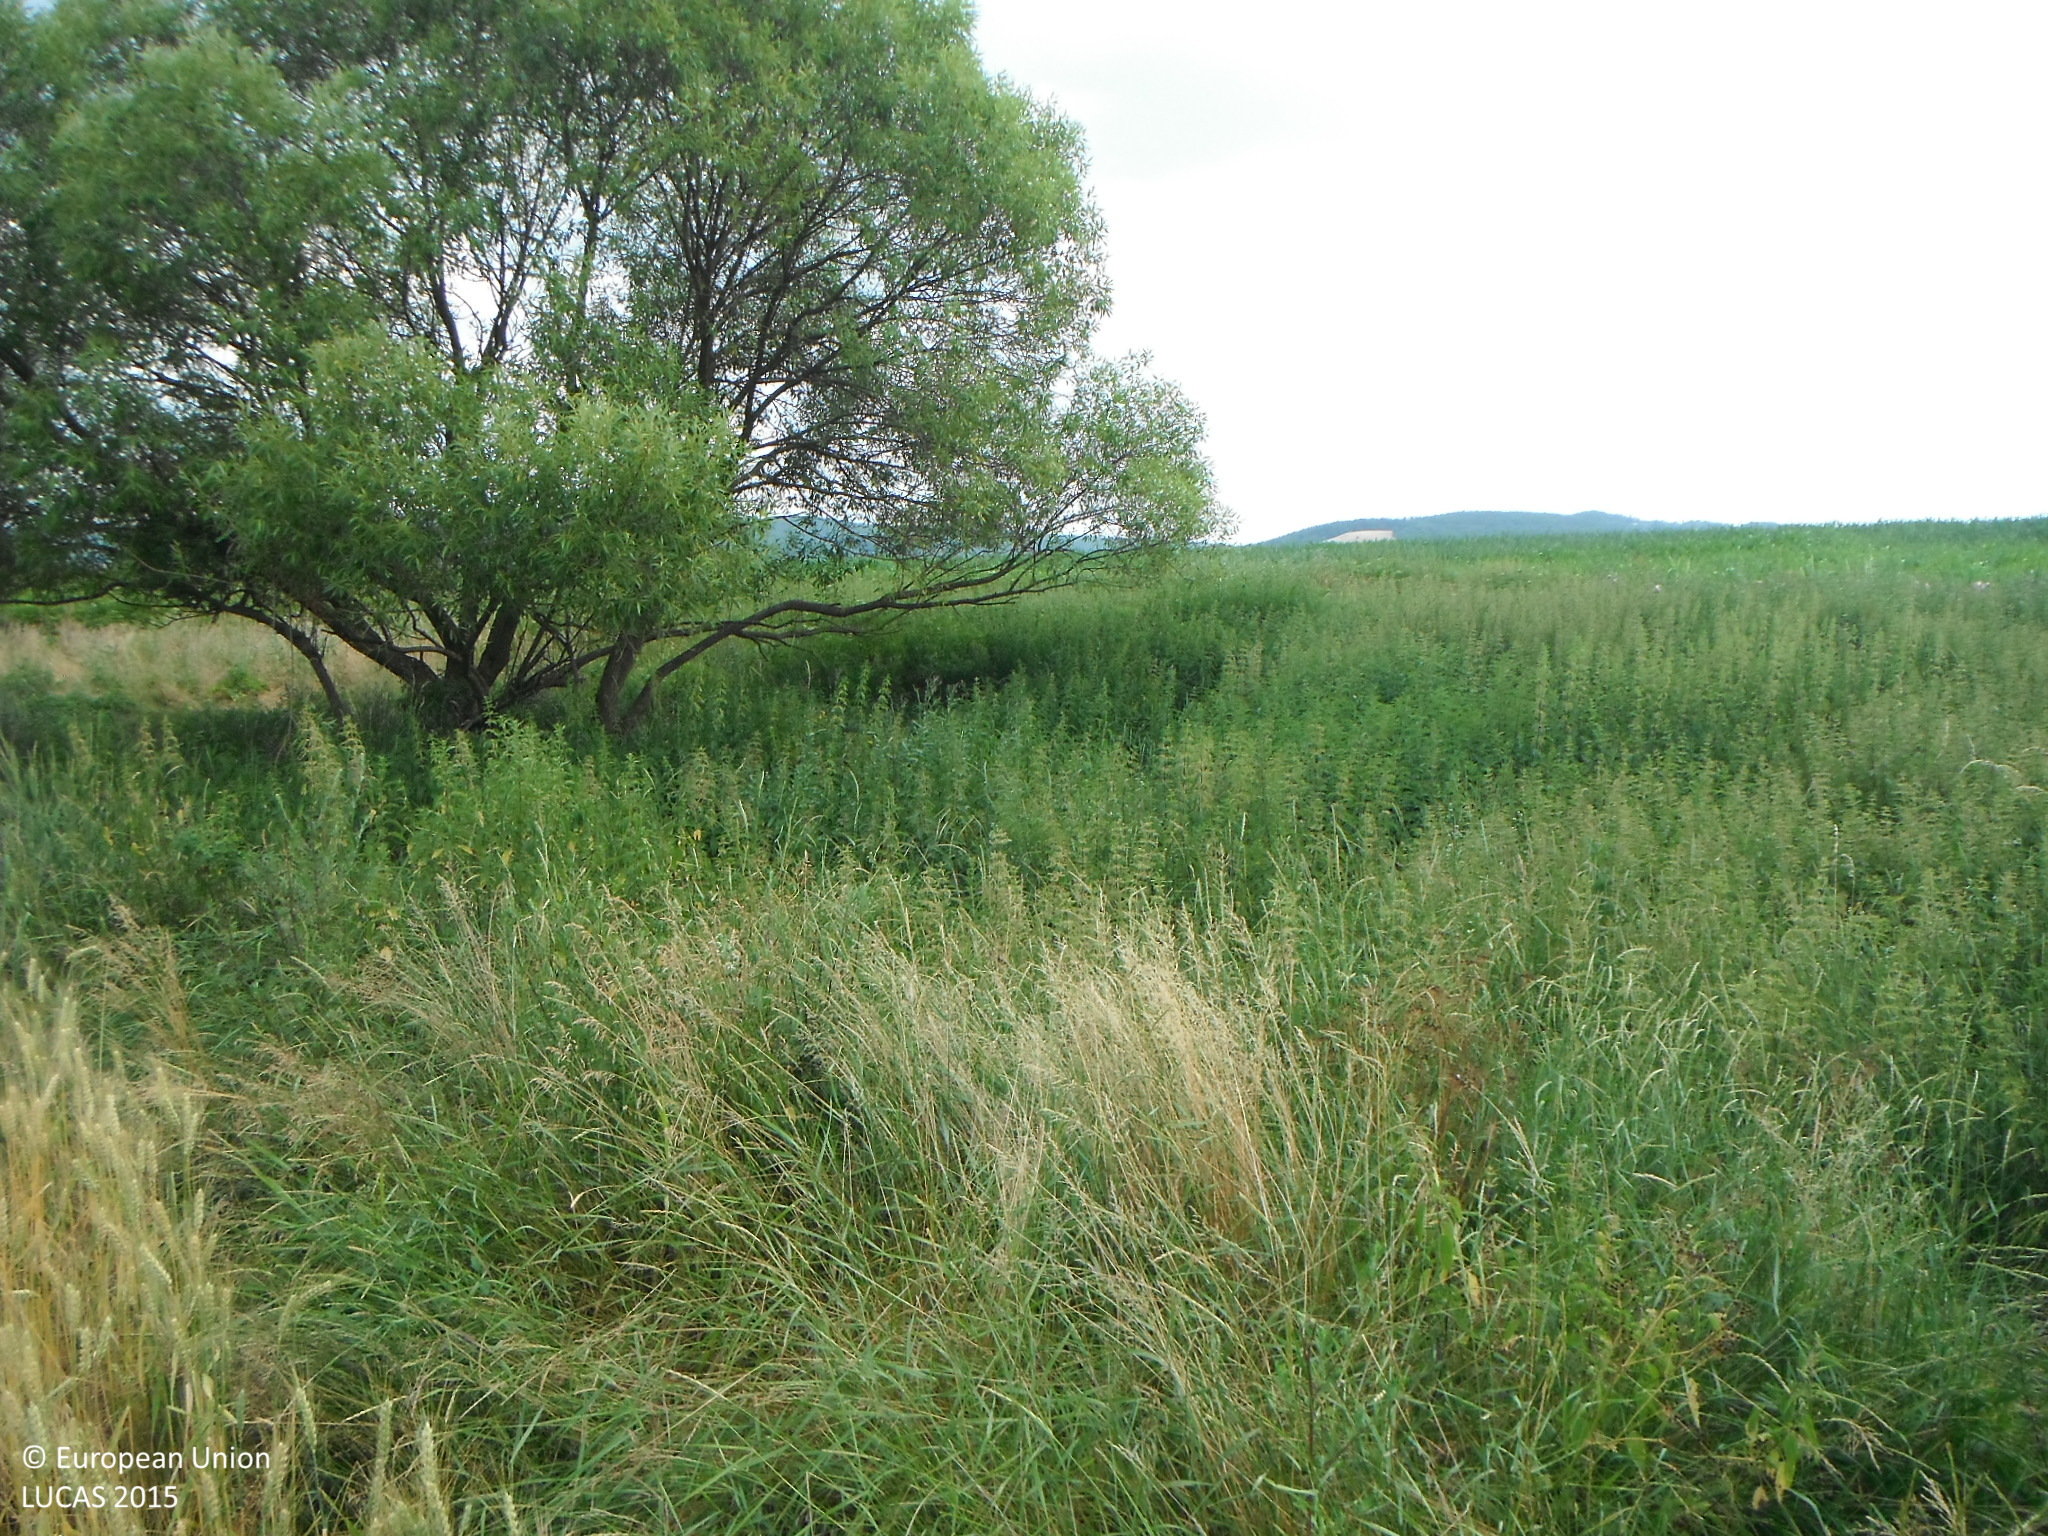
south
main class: Cropland
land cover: Common wheat
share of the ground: > 75 %
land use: Agriculture (excluding fallow land and kitchen gardens)
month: July
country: SK
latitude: 48.4201
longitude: 19.1697
